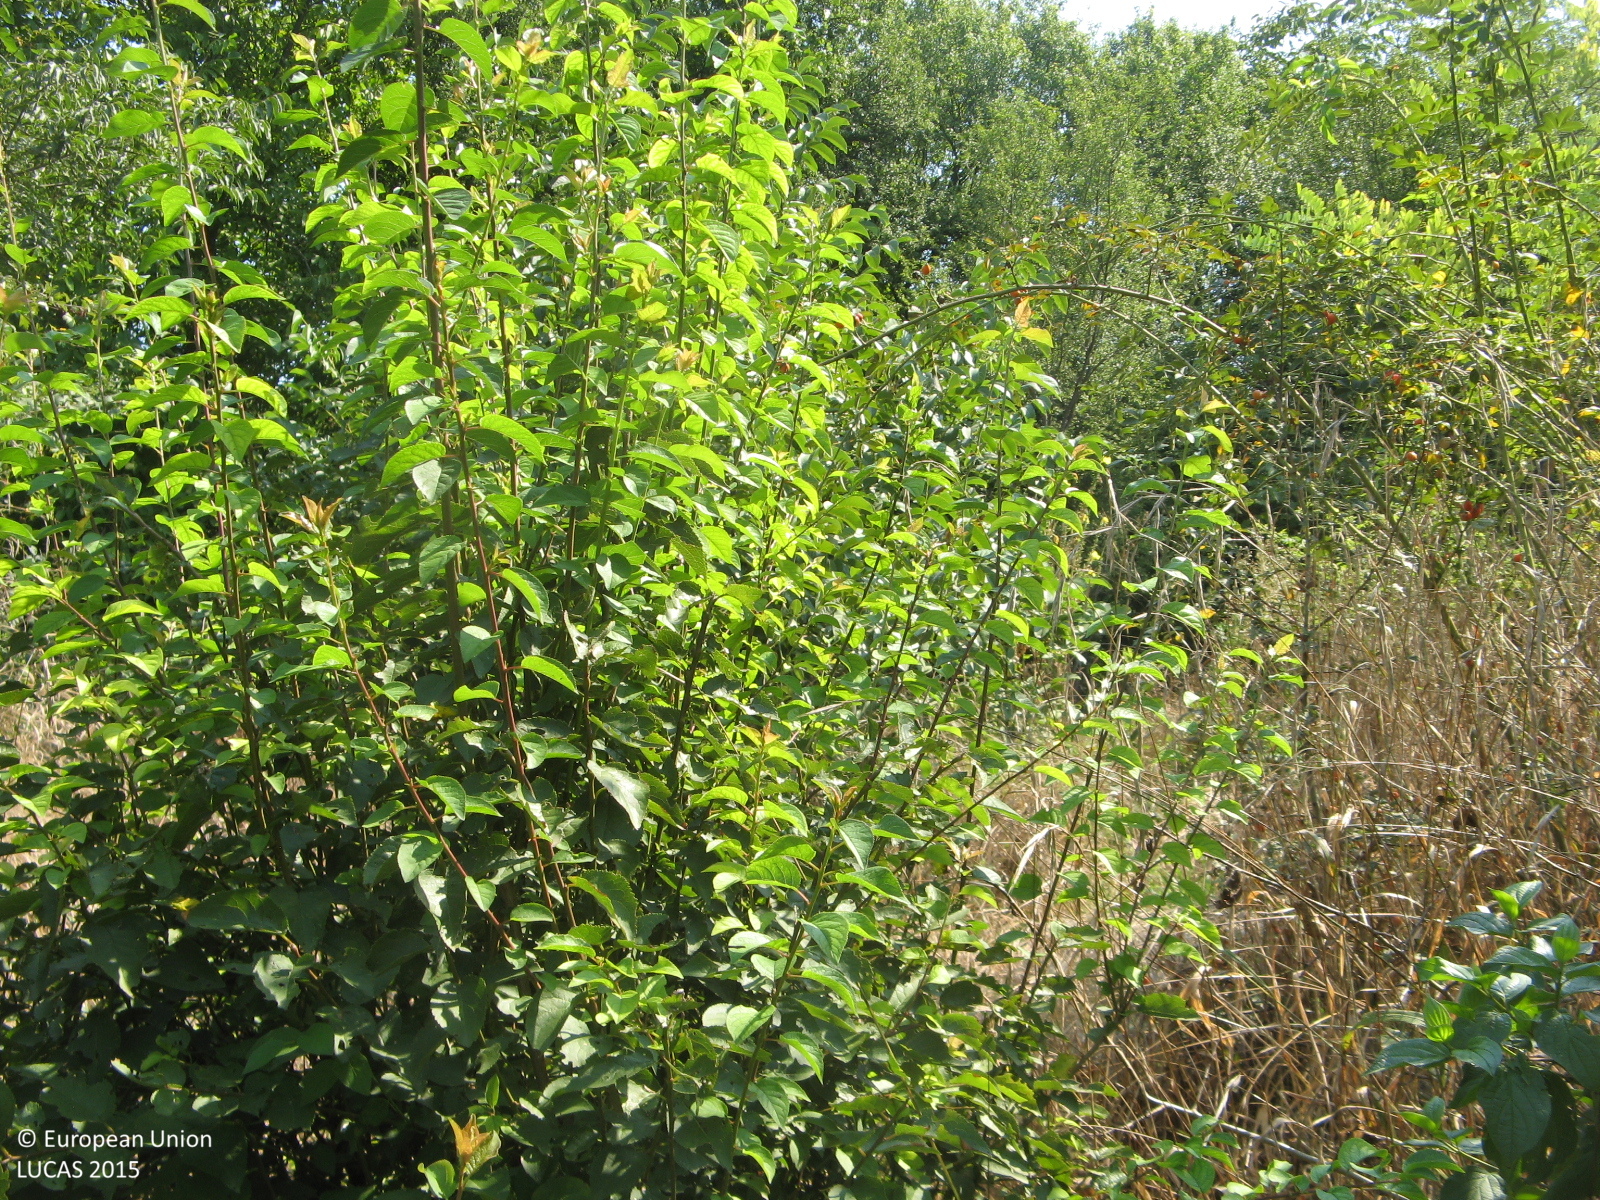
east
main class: Shrubland
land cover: Shrubland with sparse tree cover
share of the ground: > 75 %
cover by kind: shrubs 90 %, broadleaved forest trees 5 %, herbaceous plants 5 %
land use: Semi-natural and natural areas not in use
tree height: > 5 m
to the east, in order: Shrubland with sparse tree cover; Tracks; Broadleaved woodland; Artificial constructions in urban areas
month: September
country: BG
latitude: 43.7608
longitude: 25.8800
